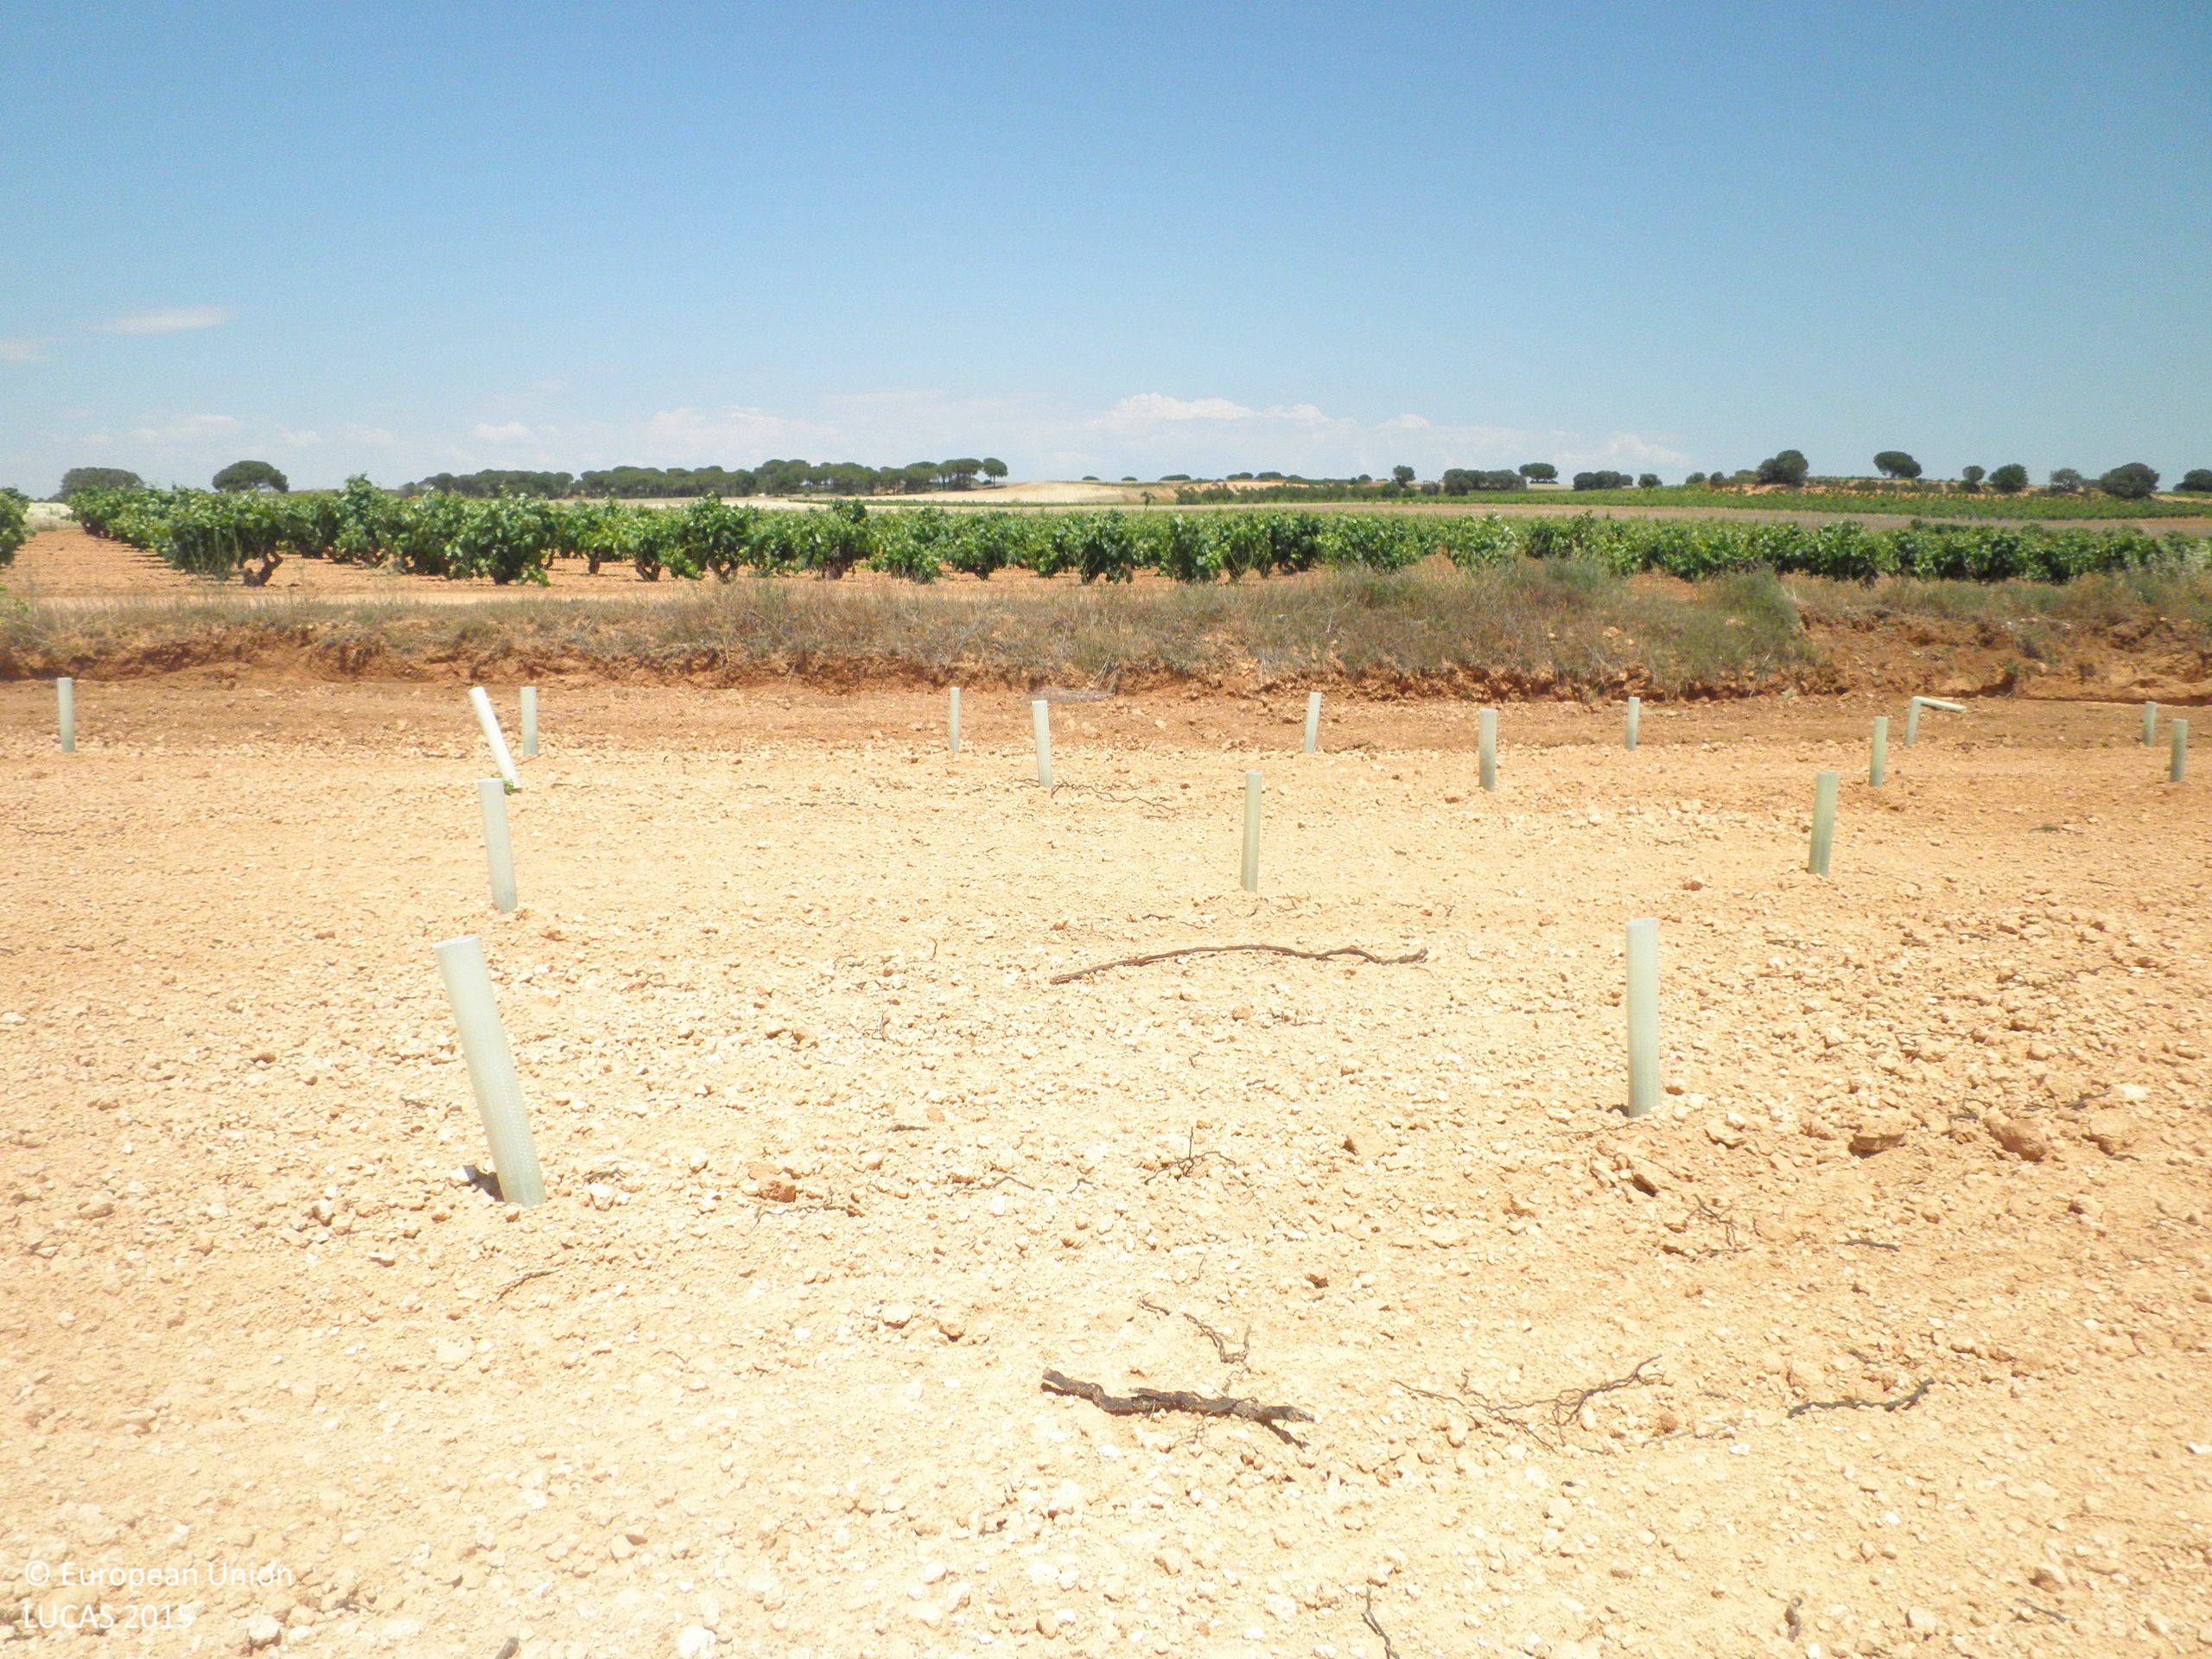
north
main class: Cropland
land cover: Vineyards
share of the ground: < 10 %
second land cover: Other bare soil
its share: > 75 %
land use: Agriculture (excluding fallow land and kitchen gardens)
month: June
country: ES
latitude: 39.4017
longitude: -1.8386
